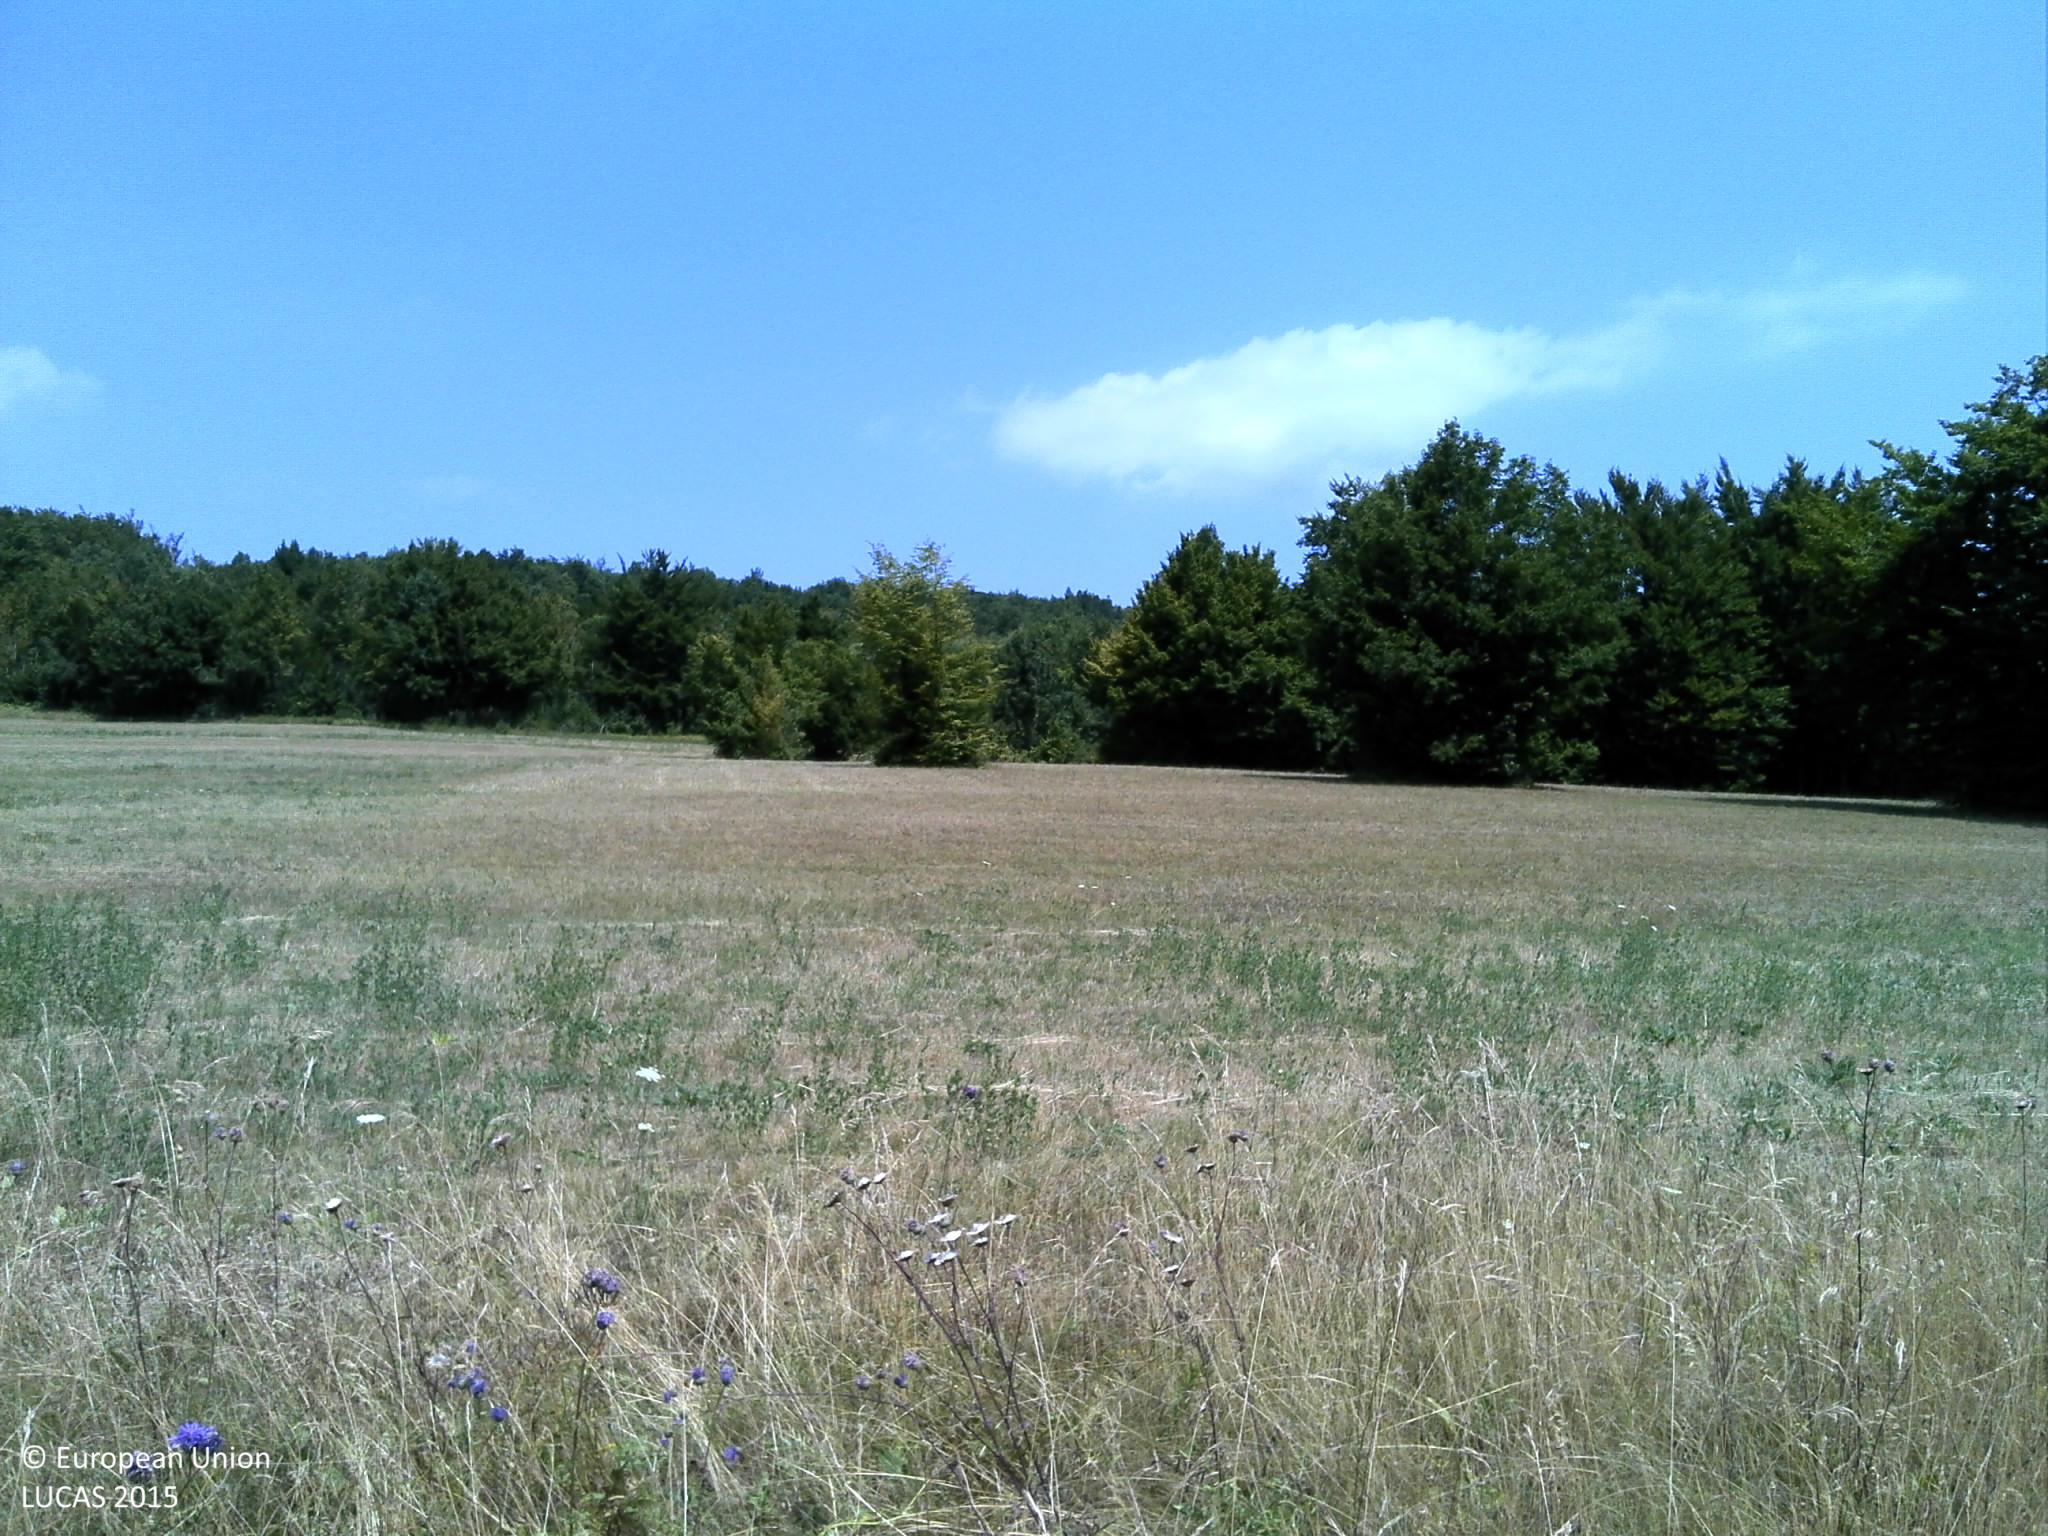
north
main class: Grassland
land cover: Grassland without tree/shrub cover
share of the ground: > 75 %
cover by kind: herbaceous plants 100 %
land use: Semi-natural and natural areas not in use
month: July
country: HR
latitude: 45.0121
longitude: 15.2604
